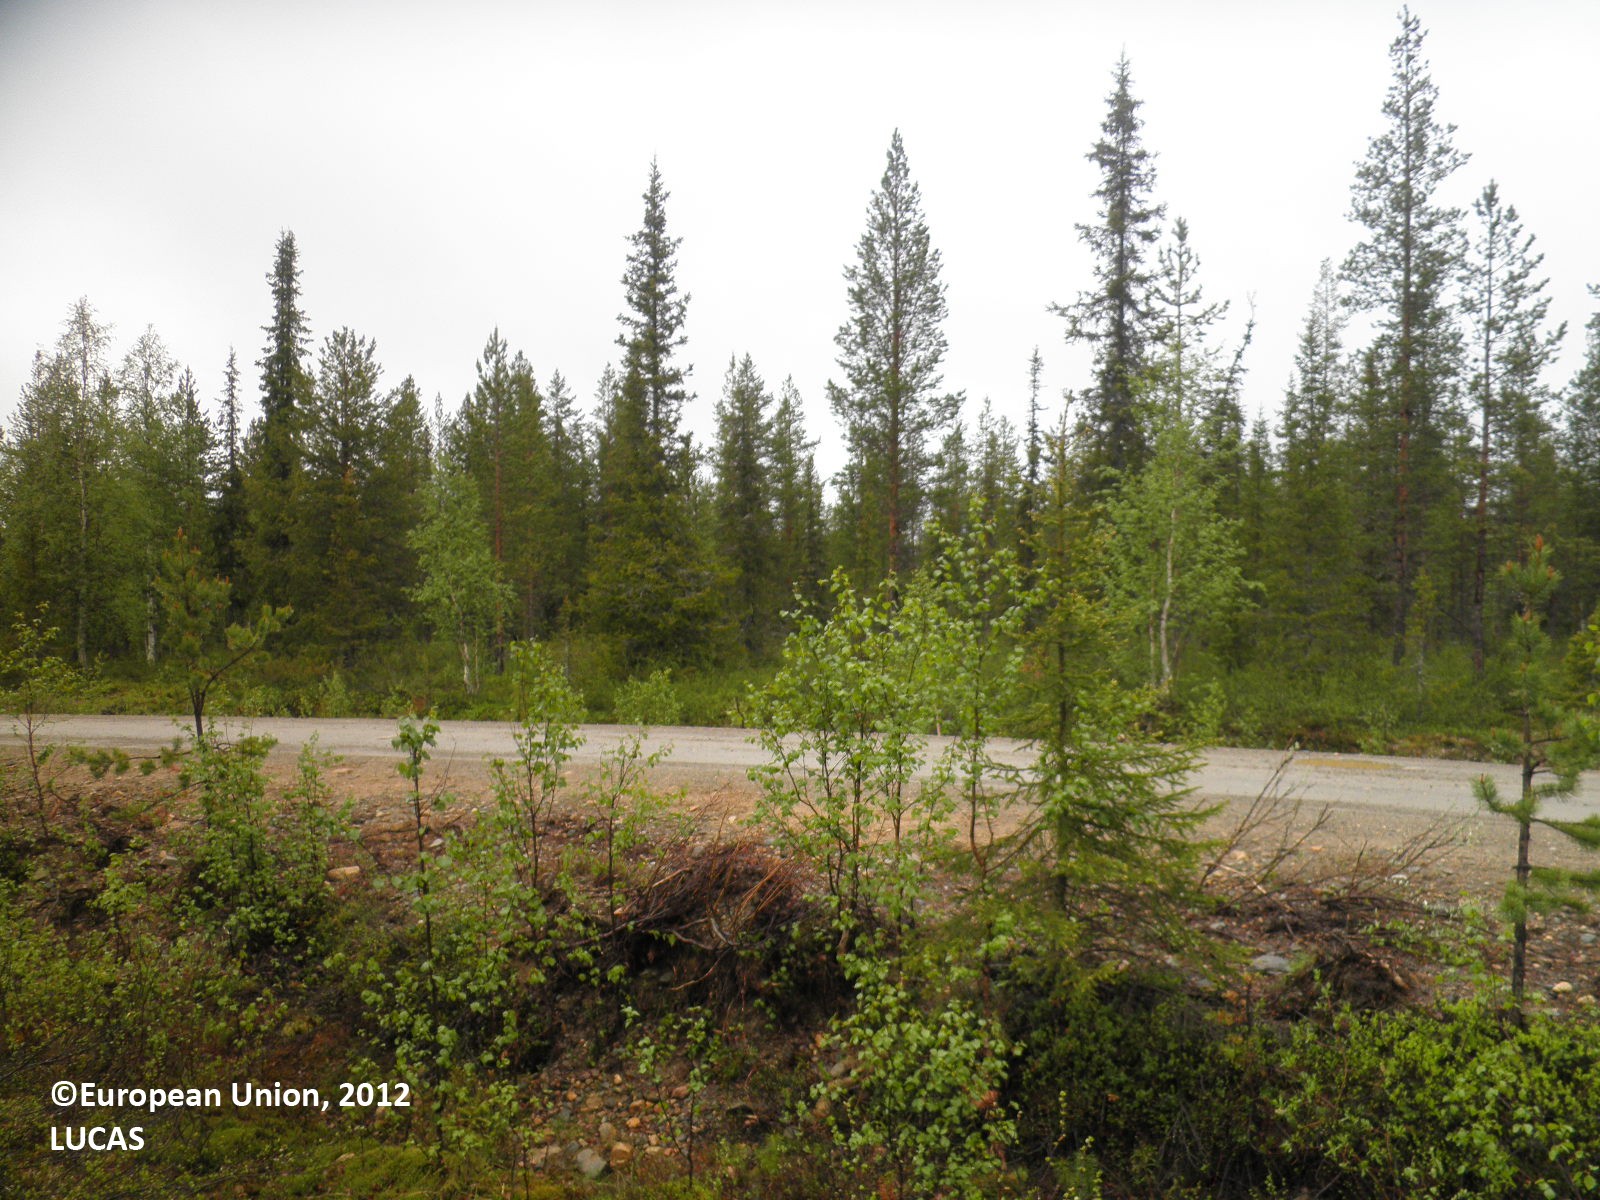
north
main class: Woodland
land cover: Pine dominated coniferous woodland
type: boreal forest
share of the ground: 50 - 75 %
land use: Forestry
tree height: > 5 m
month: June
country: FI
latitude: 67.9839
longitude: 25.5077
